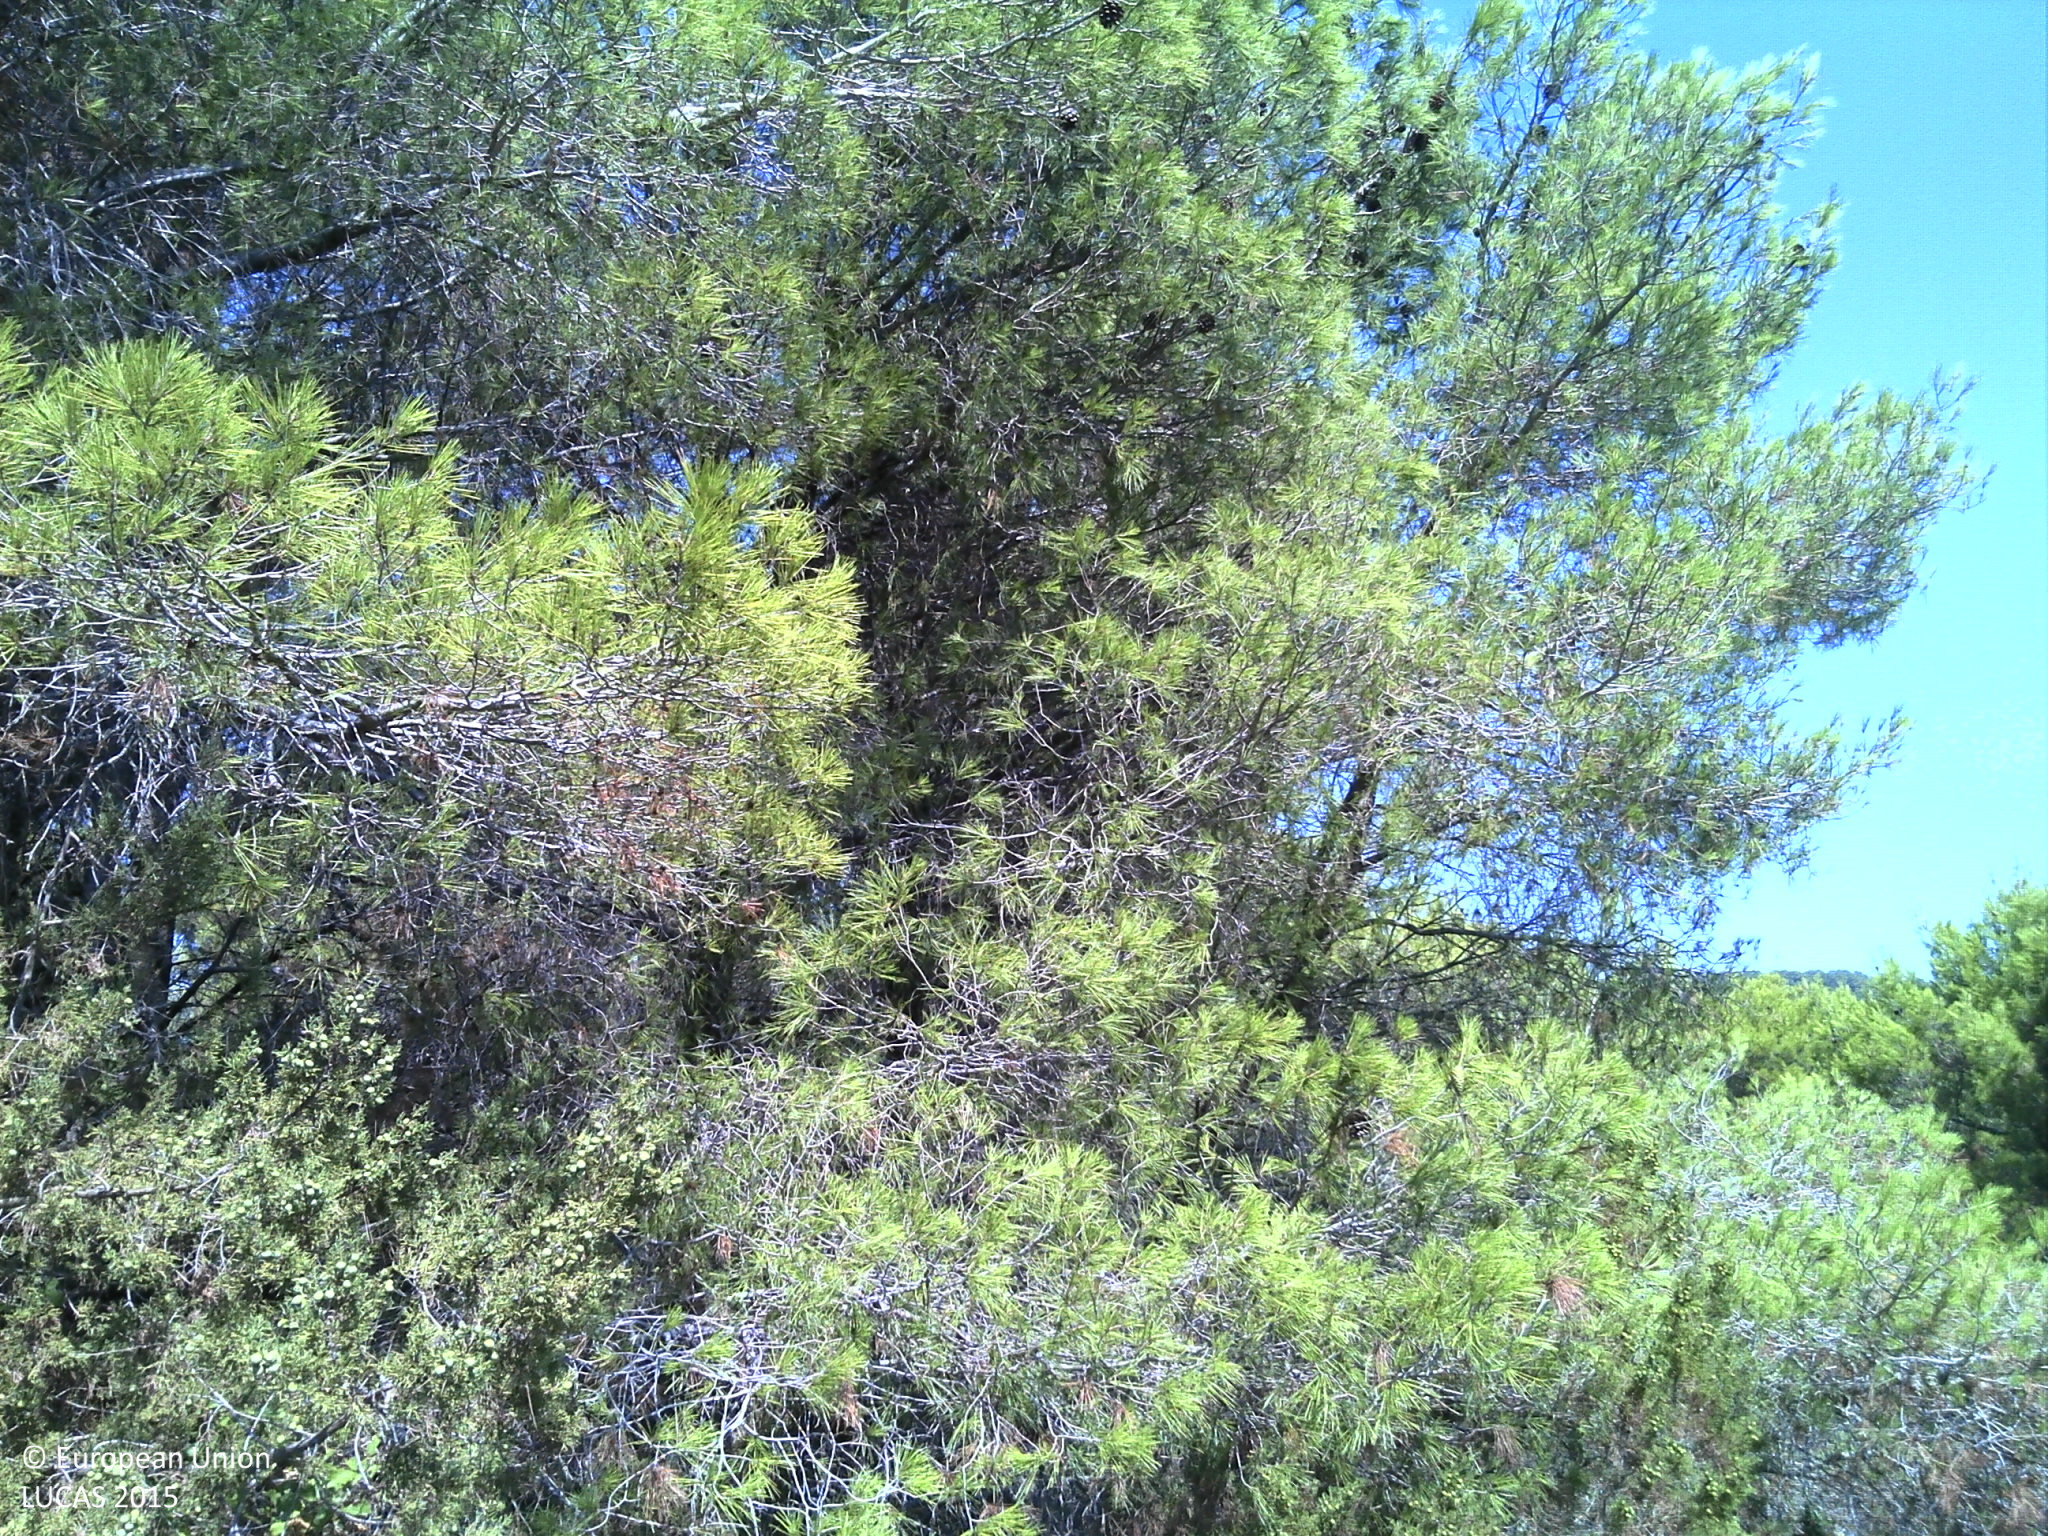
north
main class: Woodland
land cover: Pine dominated coniferous woodland
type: coniferous forest of the mediterranean region
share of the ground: > 75 %
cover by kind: coniferous forest trees 75 %, shrubs 10 %, herbaceous plants 10 %, unconsolidated bare surface 5 %
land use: Semi-natural and natural areas not in use
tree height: > 5 m
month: August
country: HR
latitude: 43.0276
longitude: 16.1614
